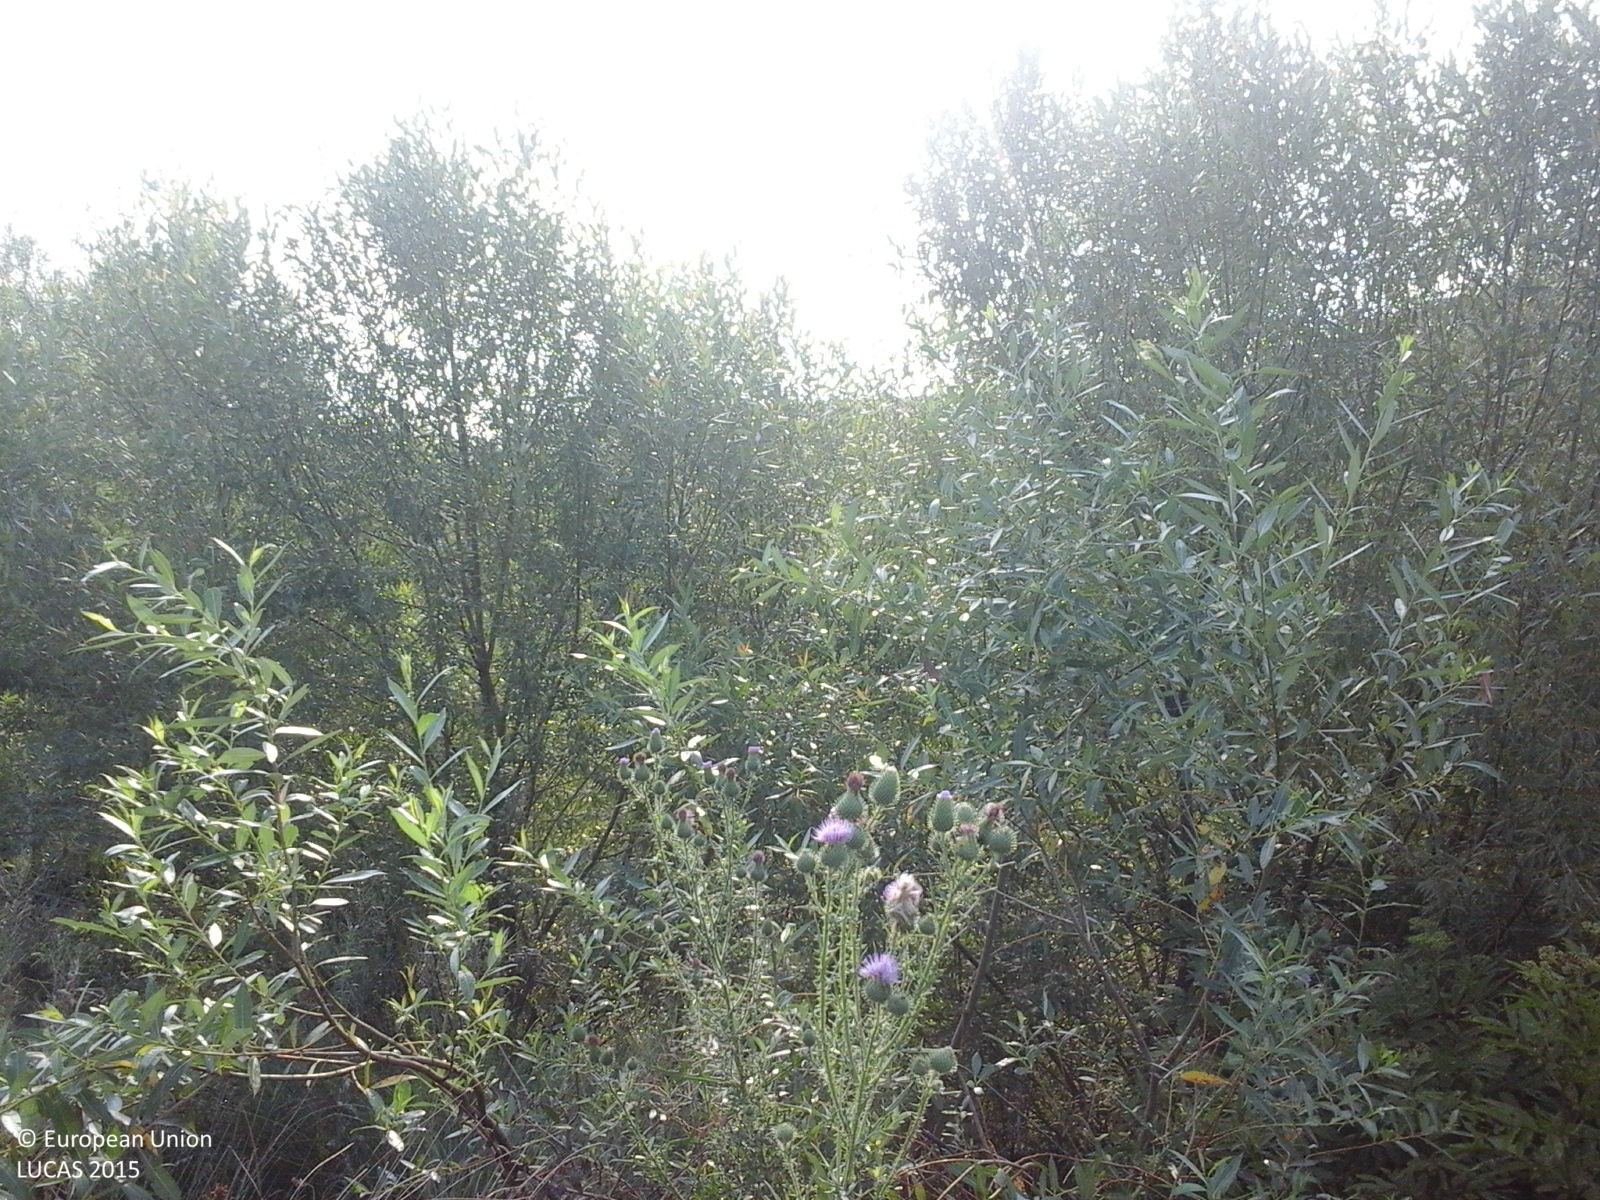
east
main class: Grassland
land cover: Grassland with sparse tree/shrub cover
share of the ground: > 75 %
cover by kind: herbaceous plants 85 %, shrubs 10 %, broadleaved forest trees 5 %
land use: Semi-natural and natural areas not in use
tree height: > 5 m
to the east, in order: Grassland with sparse tree/shrub cover; Broadleaved woodland; Ditches and canals; Broadleaved woodland; Grassland with sparse tree/shrub cover; Grassland without tree/shrub cover
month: August
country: RO
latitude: 44.5738
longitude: 23.6696
